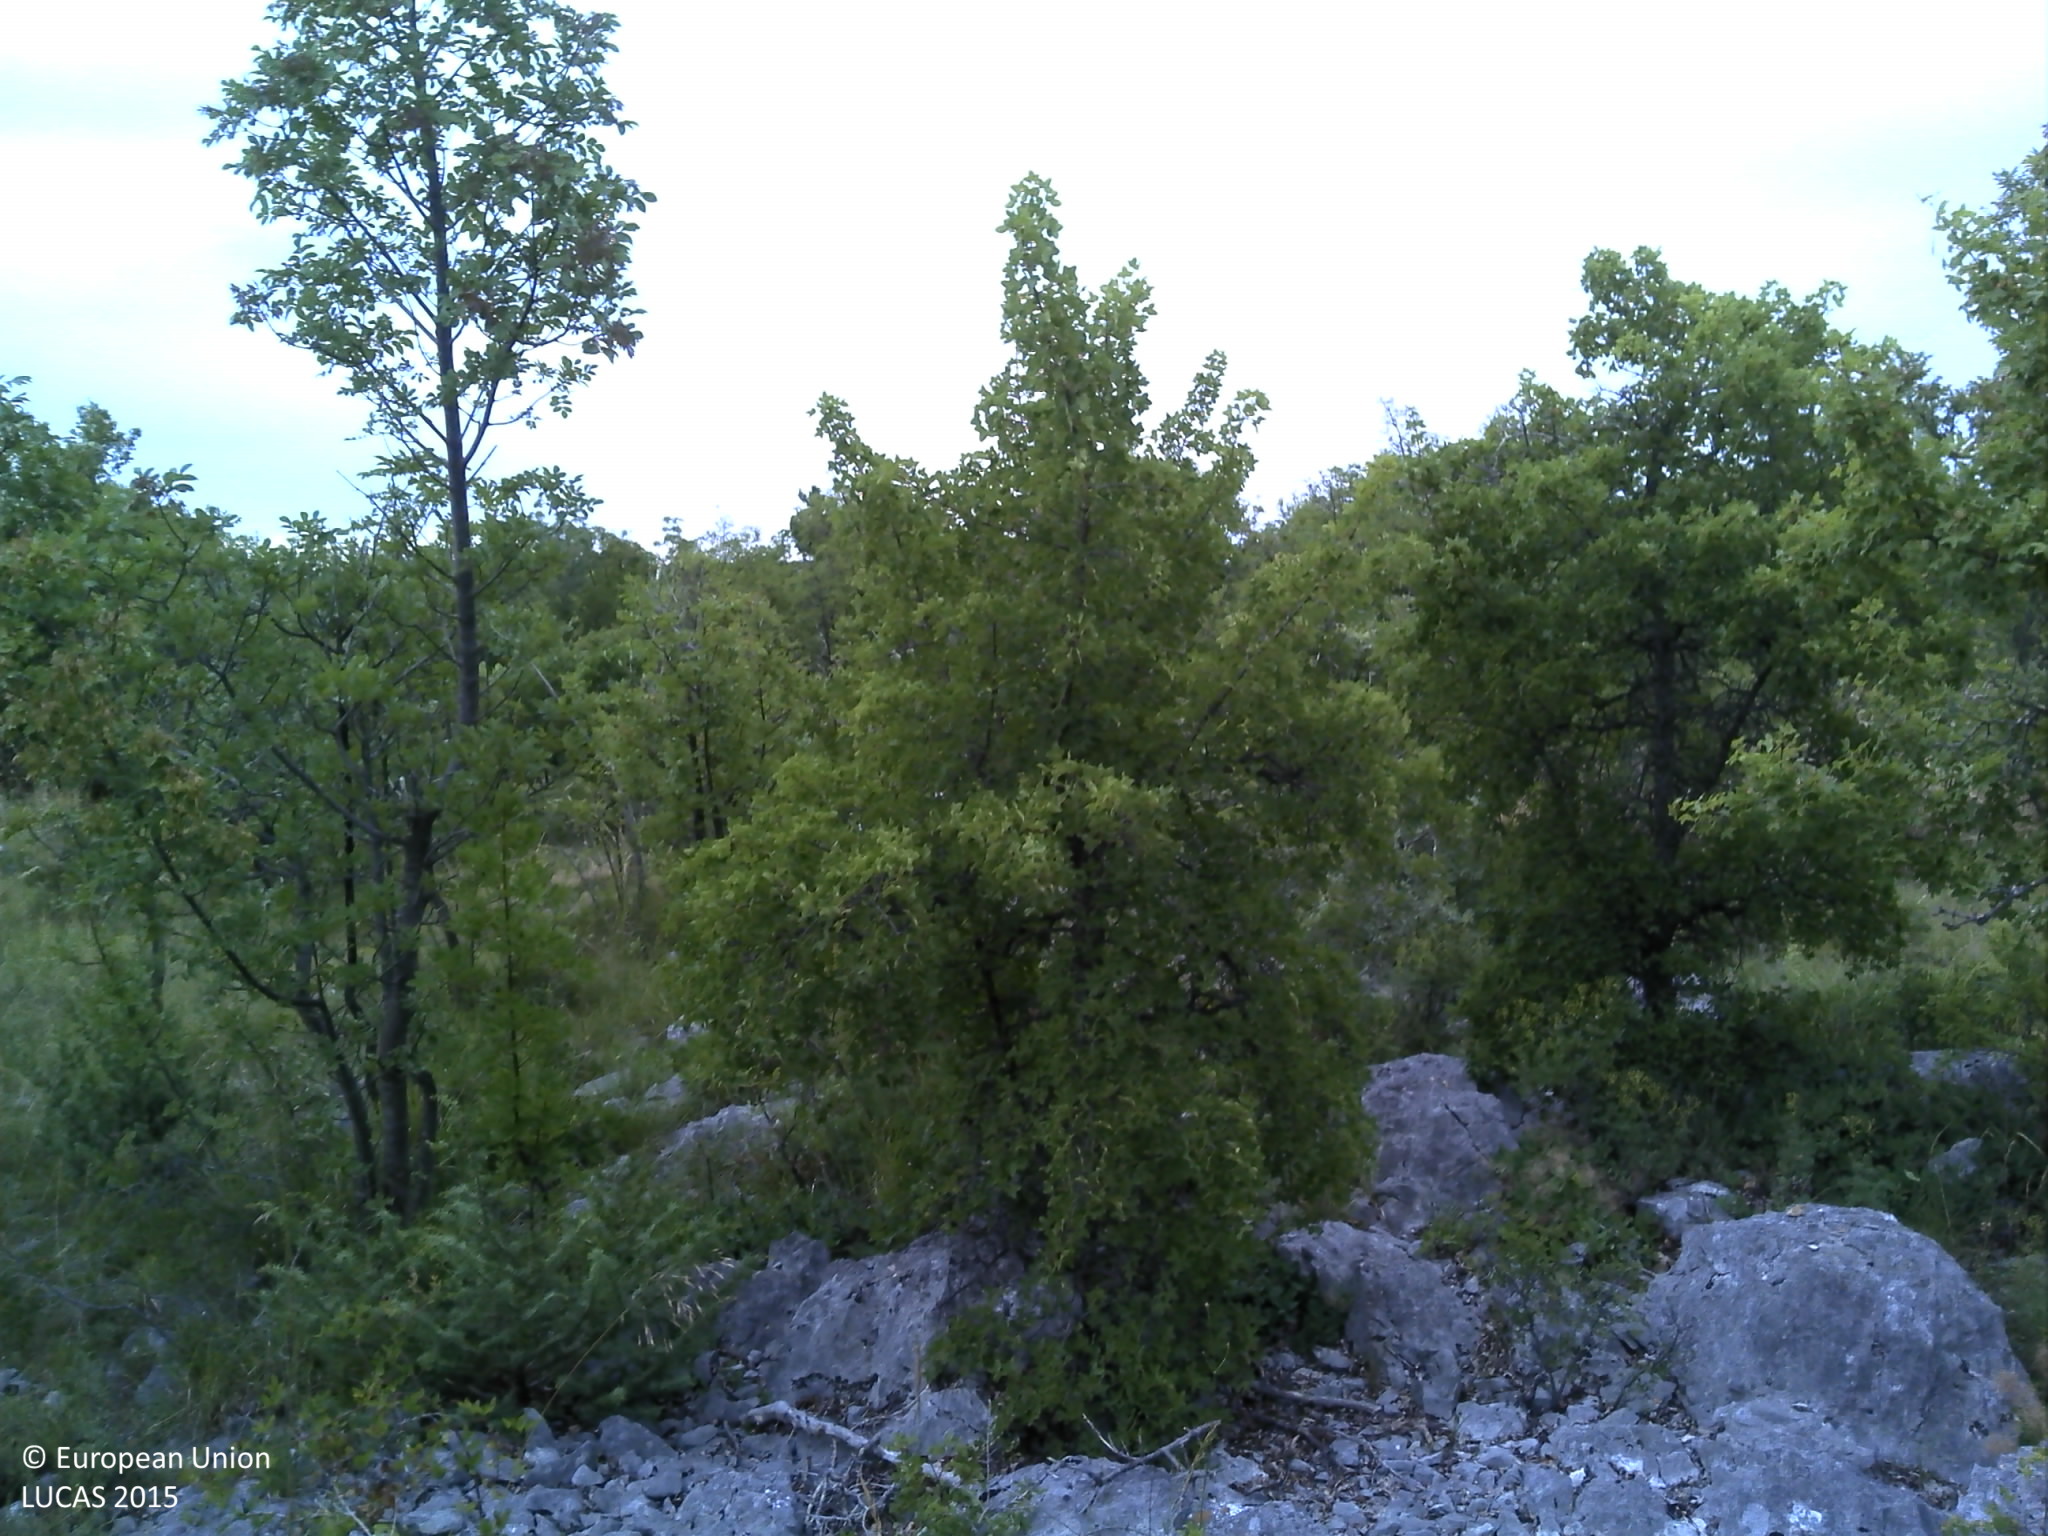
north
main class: Woodland
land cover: Broadleaved woodland
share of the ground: 10 - 25 %
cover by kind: shrubs 40 %, unconsolidated bare surface 30 %, broadleaved forest trees 20 %, consolidated bare surface 10 %
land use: Semi-natural and natural areas not in use
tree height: > 5 m
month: June
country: HR
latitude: 44.0268
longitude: 16.0933
